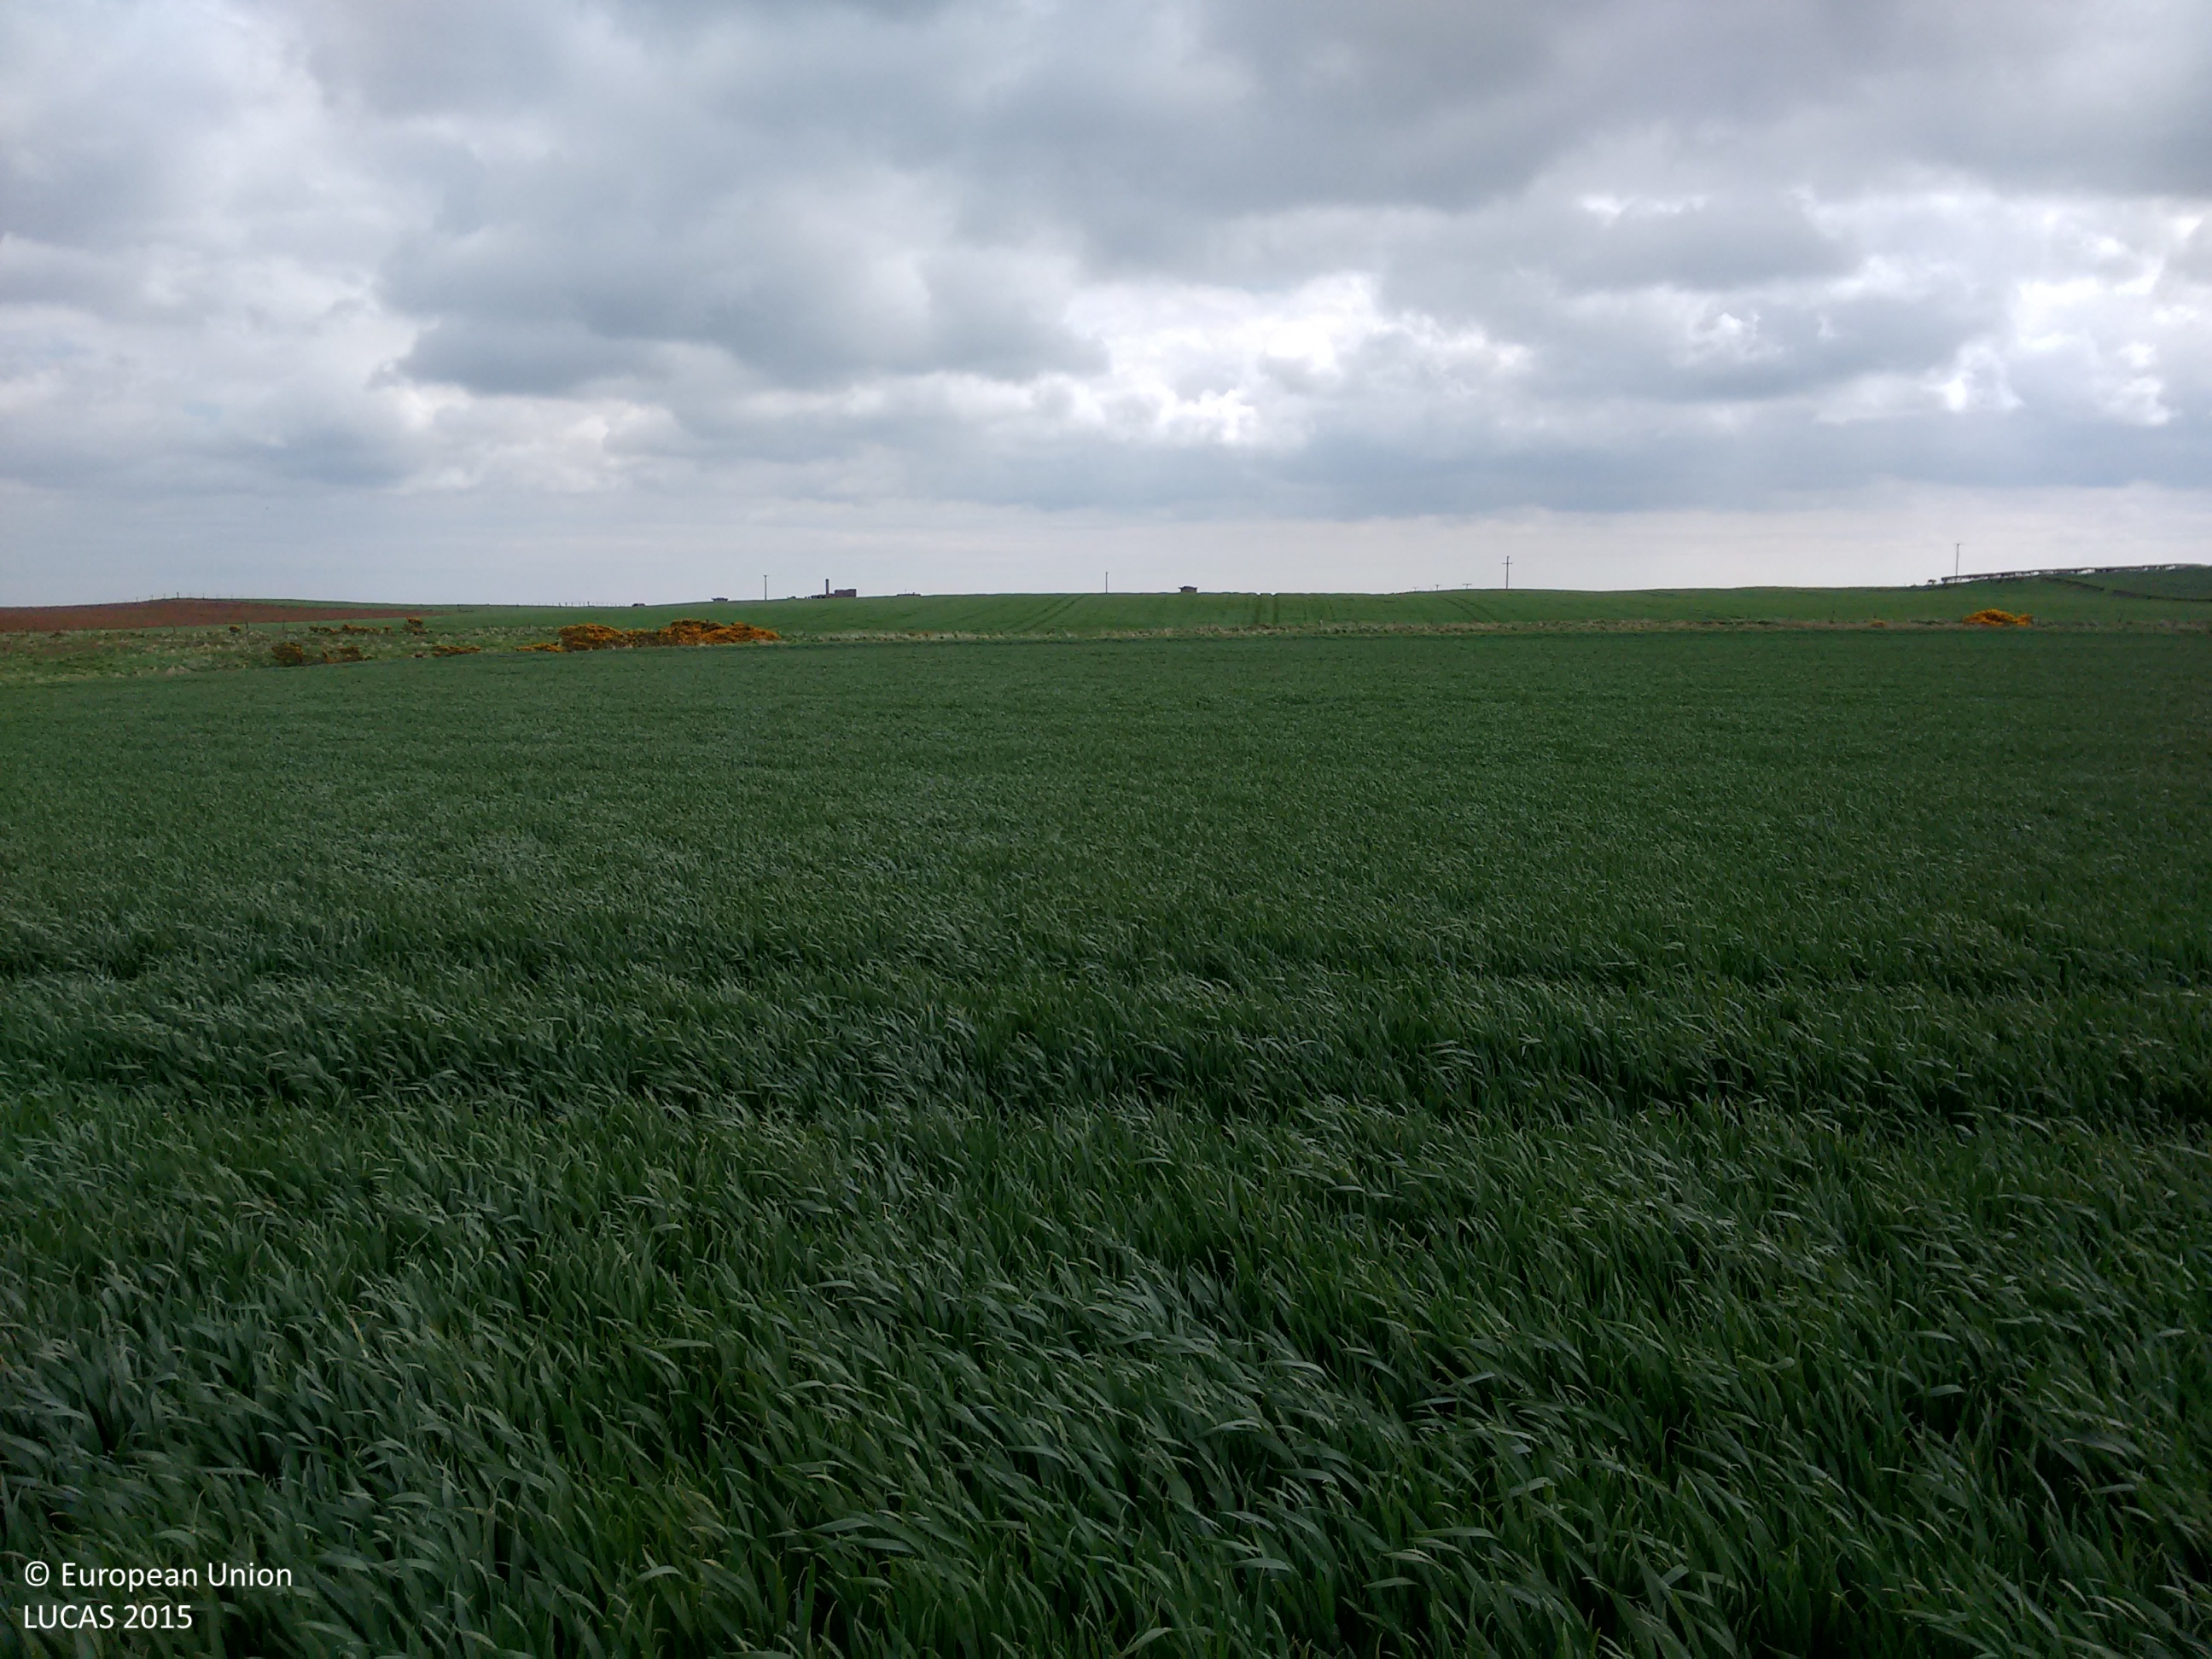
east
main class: Cropland
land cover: Common wheat
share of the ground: > 75 %
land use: Agriculture (excluding fallow land and kitchen gardens)
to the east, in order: Common wheat; Other bare soil; Grassland without tree/shrub cover; Fences; Grass margins; Barley
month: May
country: GB
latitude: 54.1498
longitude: -0.1837
